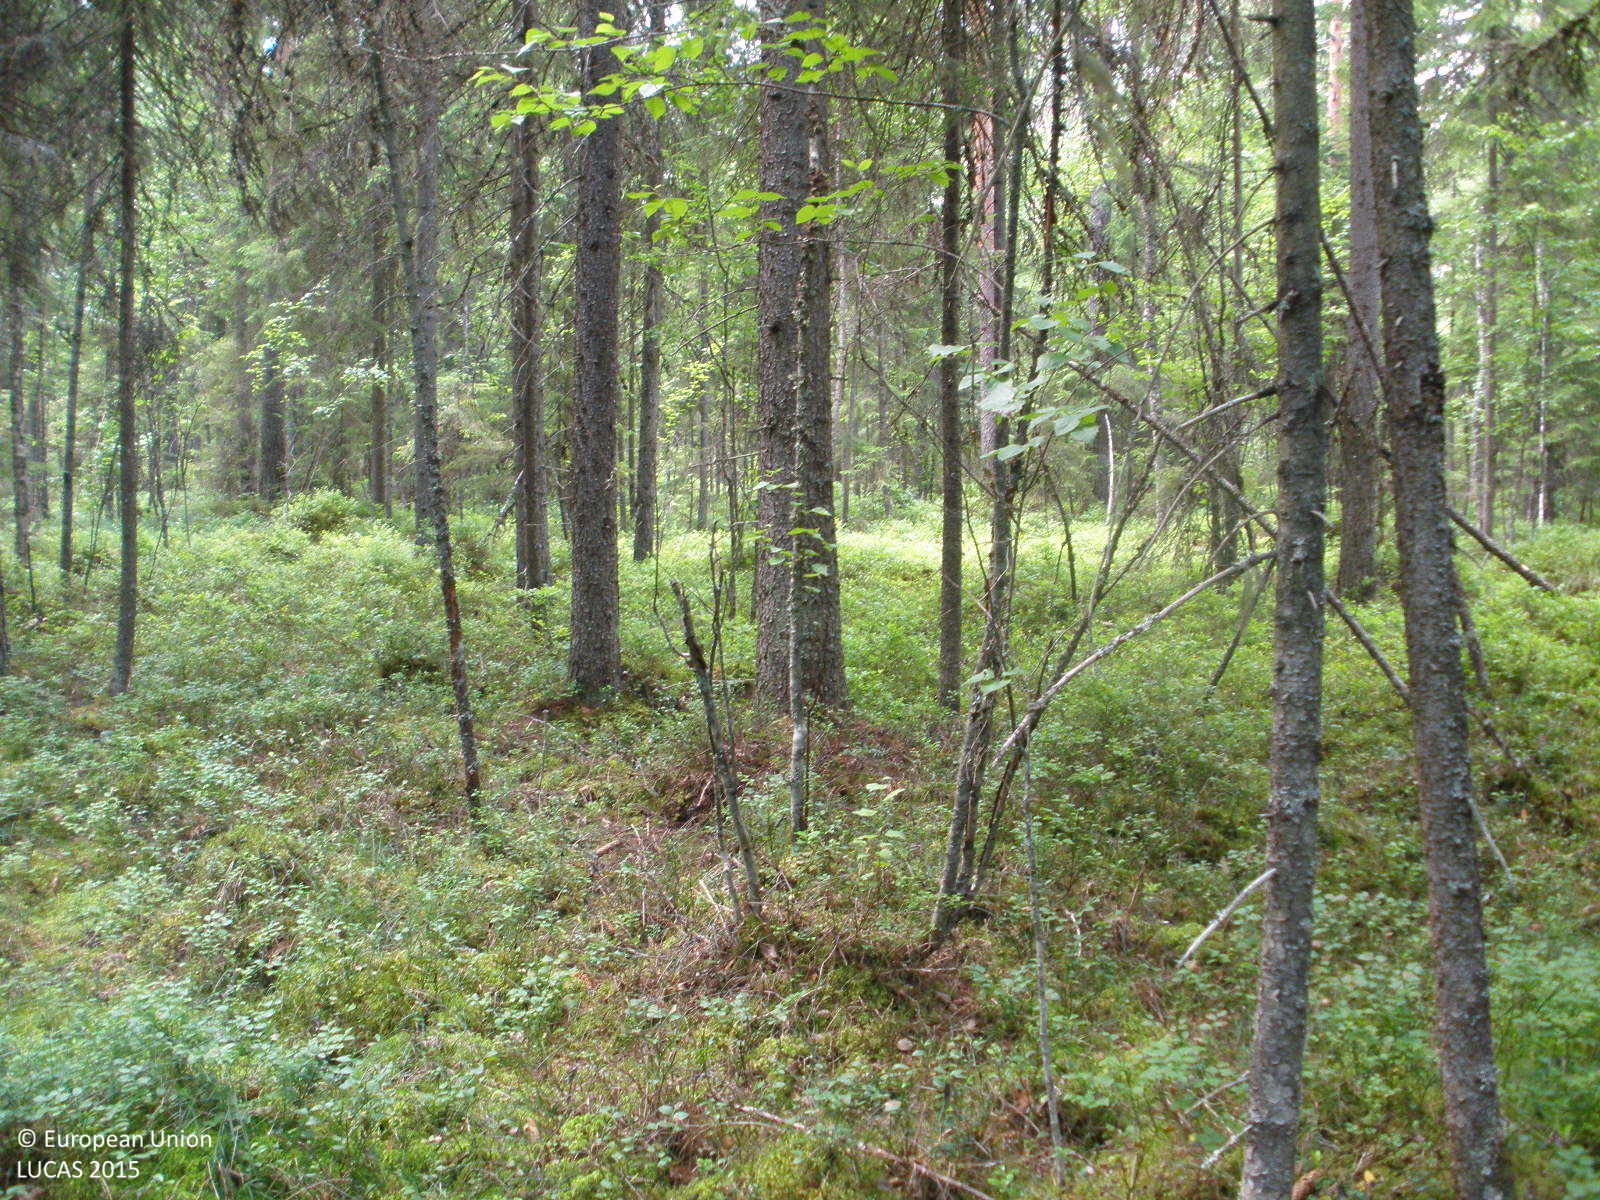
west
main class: Woodland
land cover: Spruce dominated coniferous woodland
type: boreal forest
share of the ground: > 75 %
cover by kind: coniferous forest trees 85 %, broadleaved forest trees 5 %, herbaceous plants 5 %, lichens and mosses 5 %
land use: Forestry
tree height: > 5 m
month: July
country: FI
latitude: 61.4901
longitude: 24.9643
